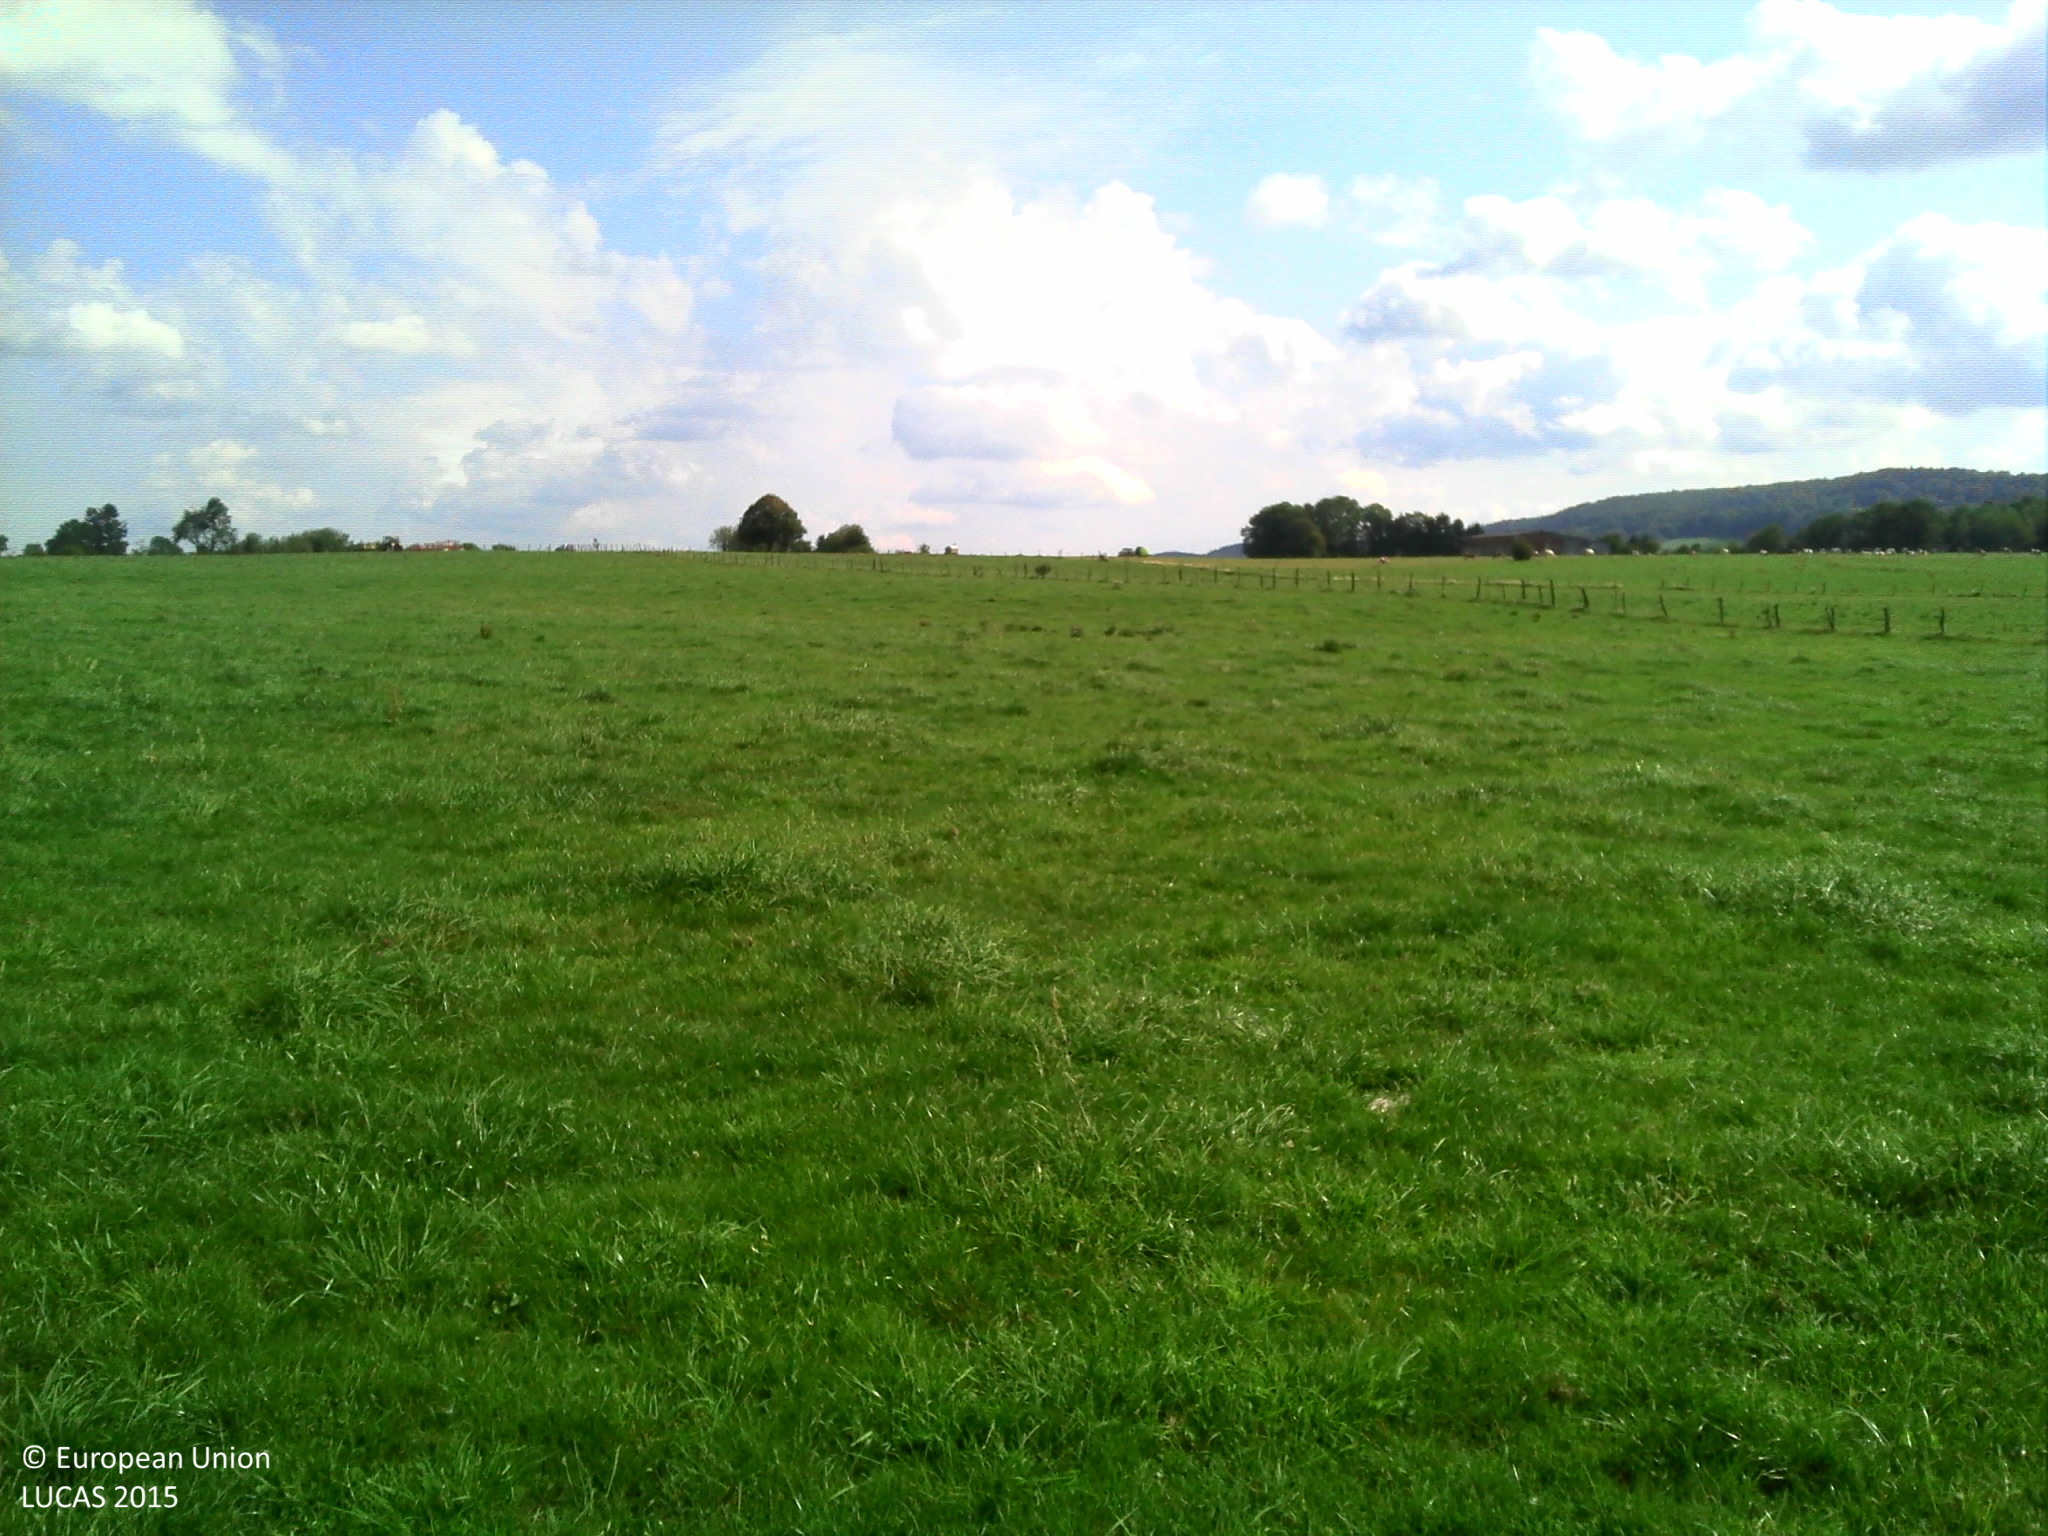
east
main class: Grassland
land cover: Grassland without tree/shrub cover
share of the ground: > 75 %
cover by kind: herbaceous plants 100 %
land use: Agriculture (excluding fallow land and kitchen gardens)
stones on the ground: < 10 %
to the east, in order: Grassland without tree/shrub cover; Fences; Grassland without tree/shrub cover; Fences; Grassland without tree/shrub cover
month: September
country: FR
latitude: 47.1730
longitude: 6.3737
